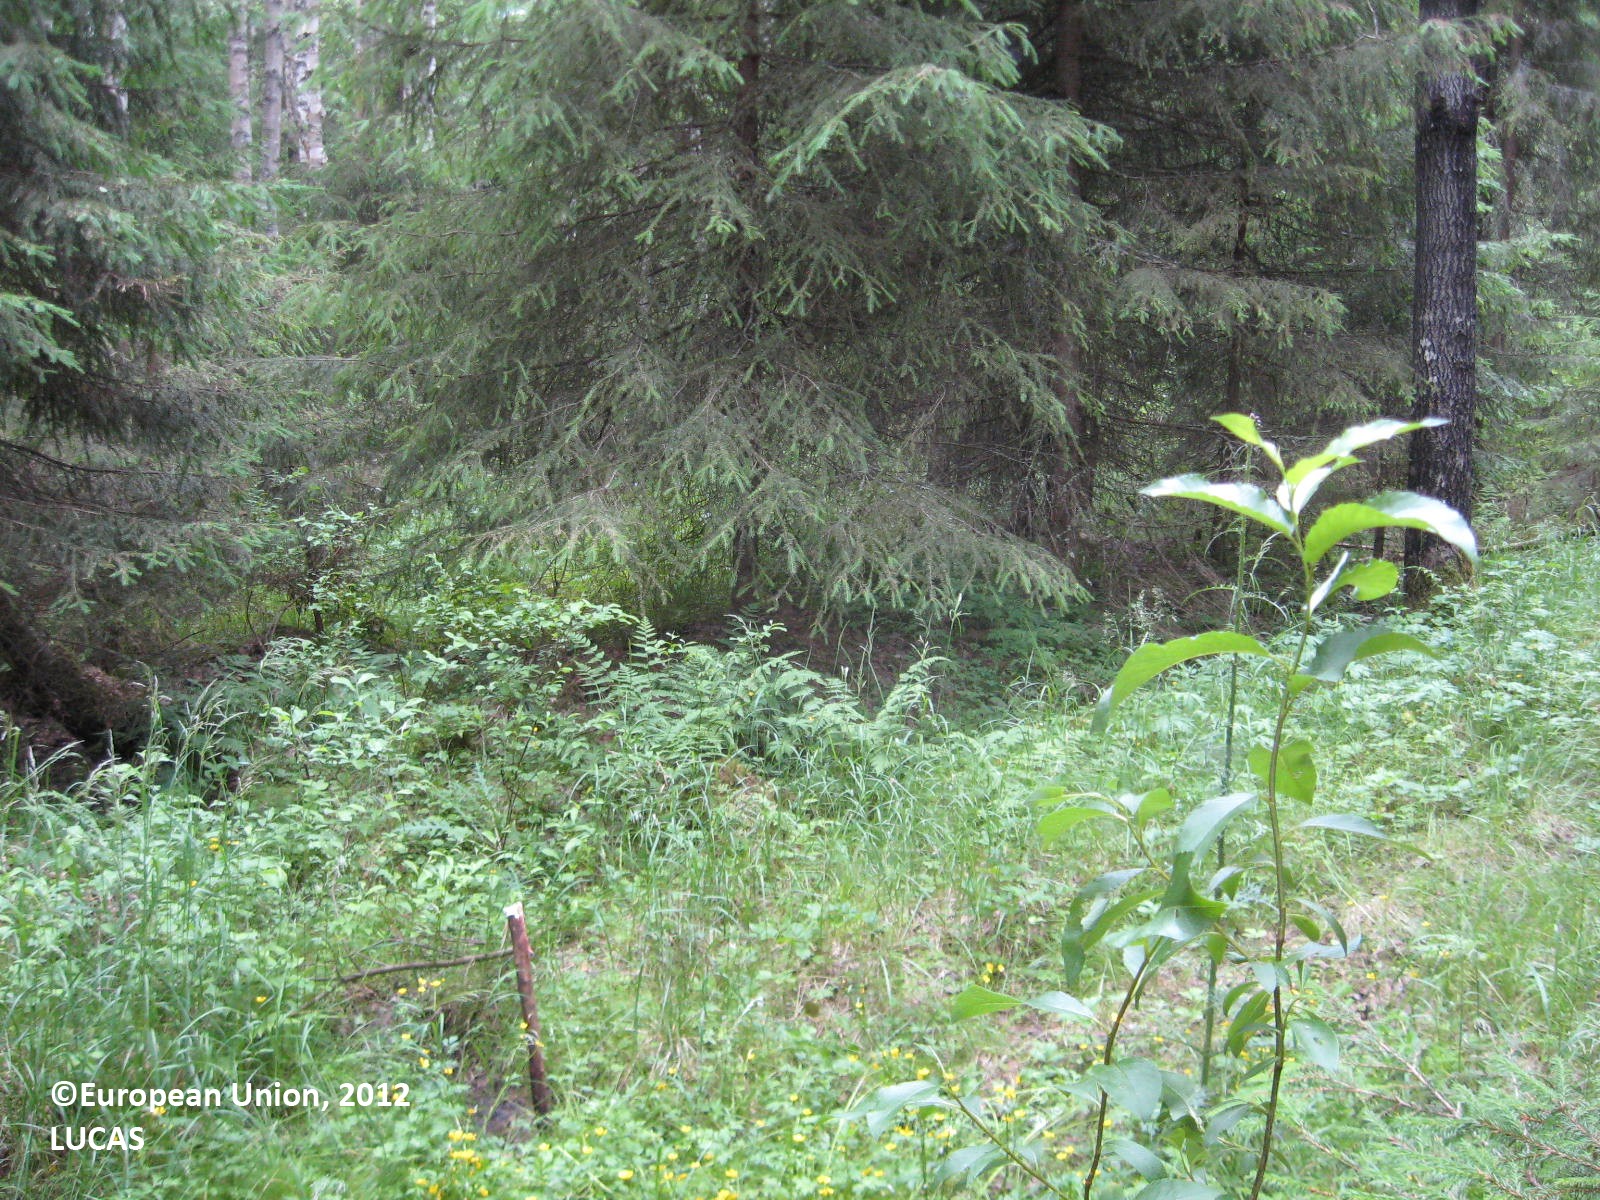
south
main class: Woodland
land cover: Spruce dominated mixed woodland
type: boreal forest
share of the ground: > 75 %
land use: Forestry
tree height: > 5 m
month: July
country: FI
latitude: 62.5015
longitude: 22.8149
